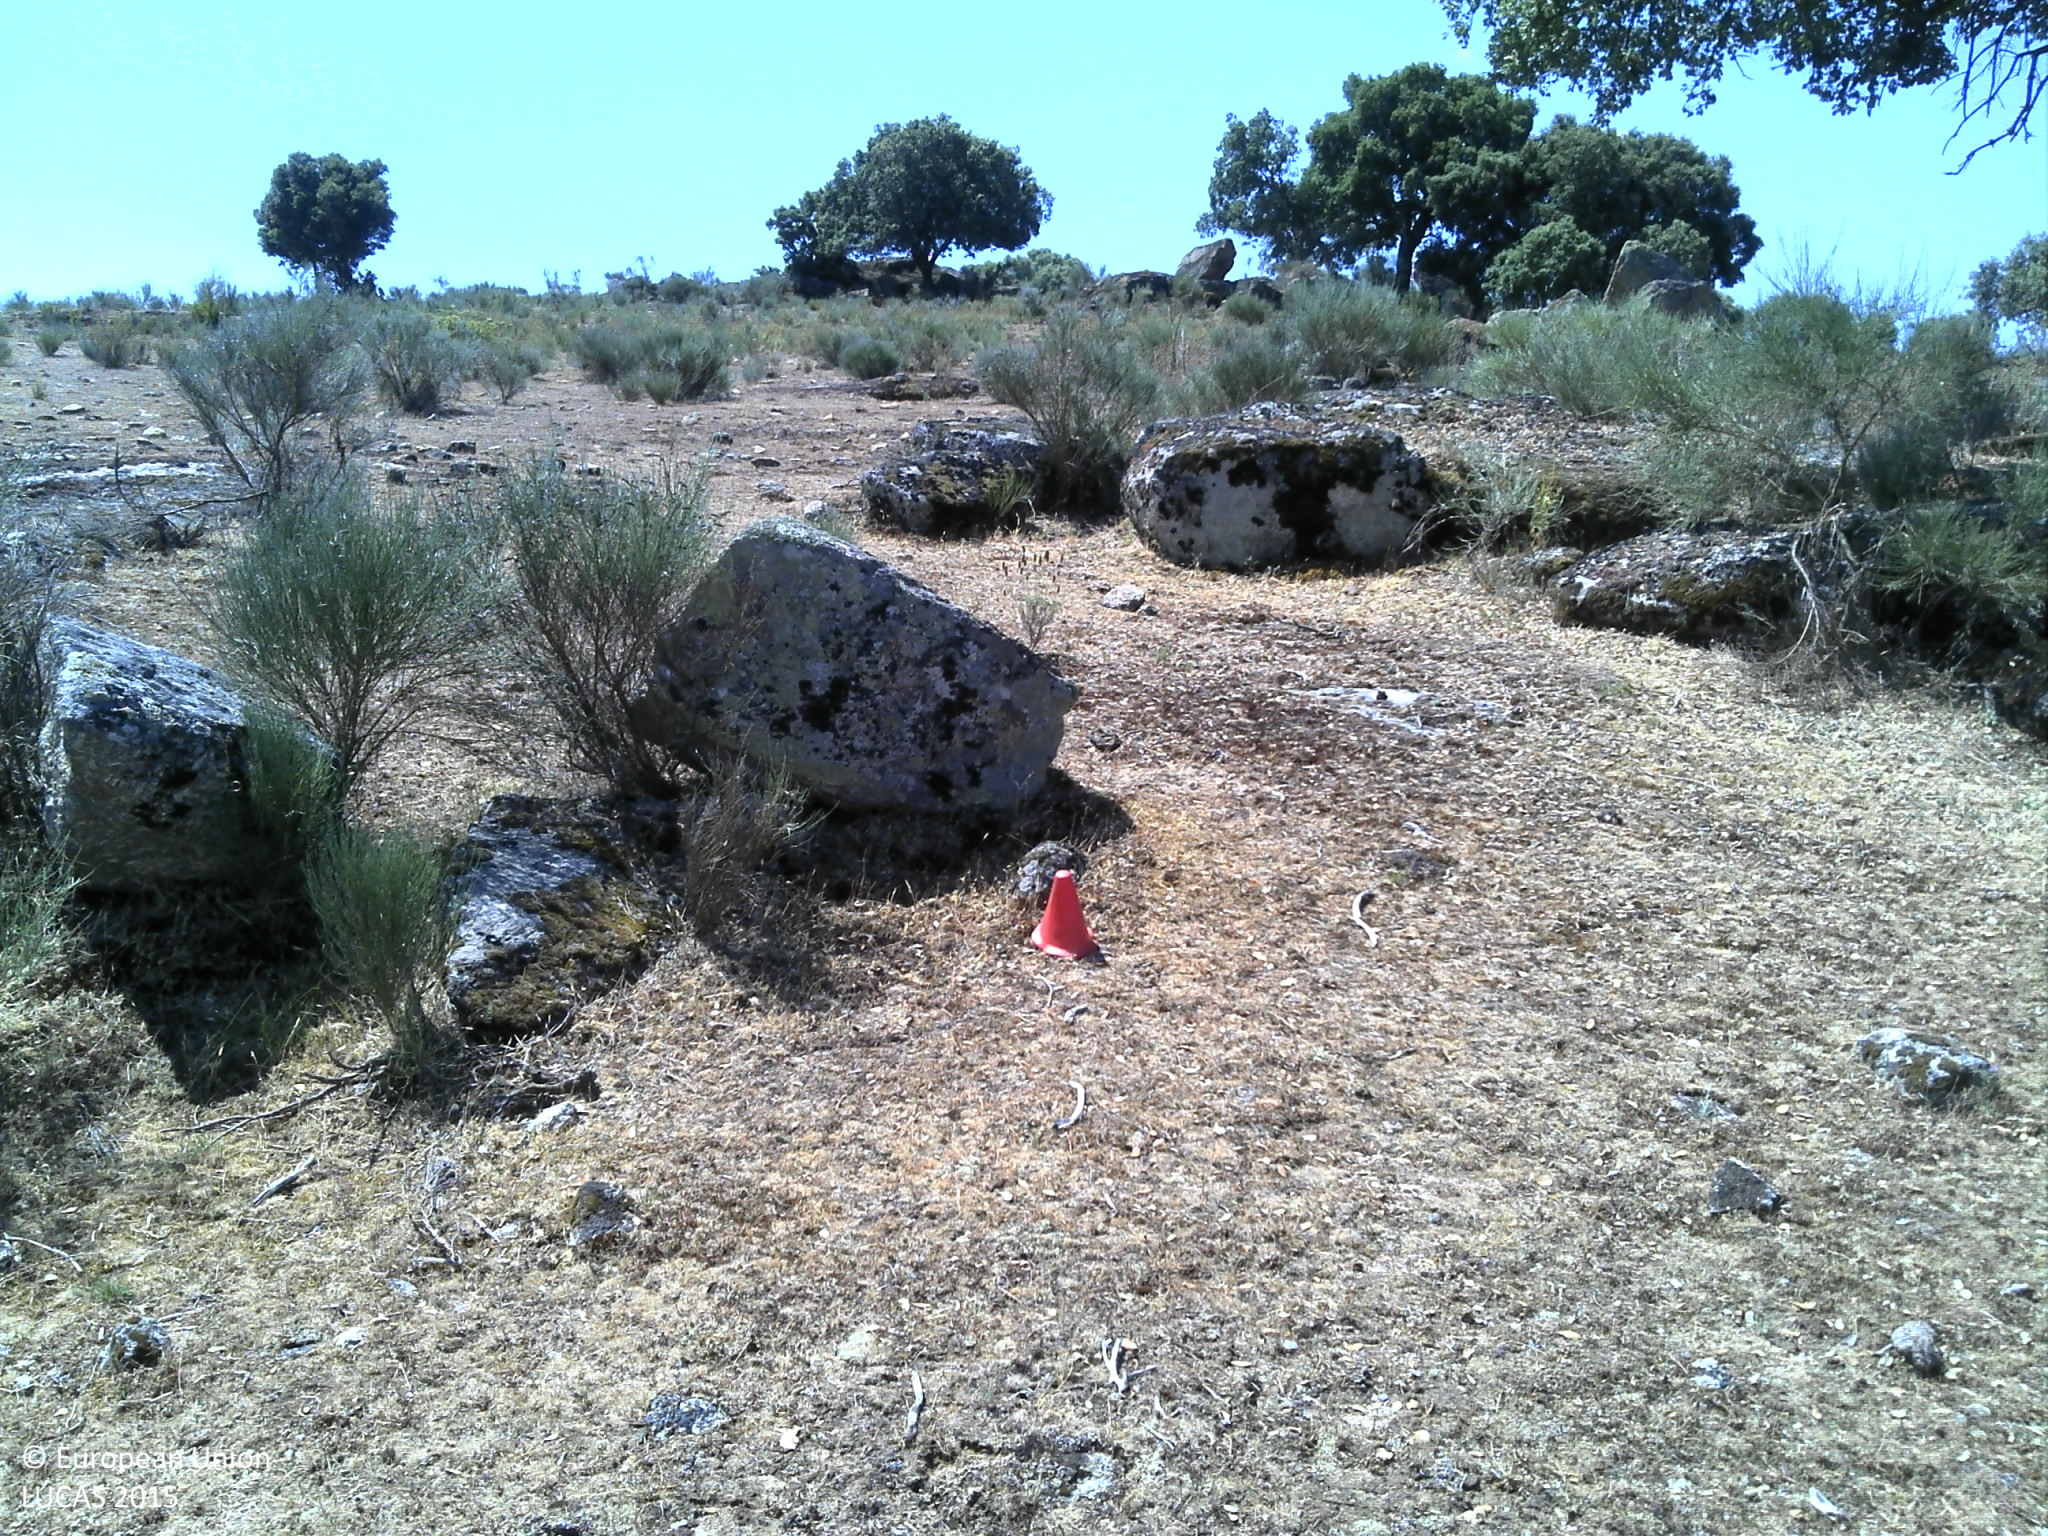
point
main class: Grassland
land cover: Grassland with sparse tree/shrub cover
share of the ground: 25 - 50 %
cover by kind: consolidated bare surface 45 %, herbaceous plants 40 %, shrubs 10 %, broadleaved forest trees 5 %
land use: Agriculture (excluding fallow land and kitchen gardens)
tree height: > 5 m
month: June
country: PT
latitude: 40.7692
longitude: -6.9609
